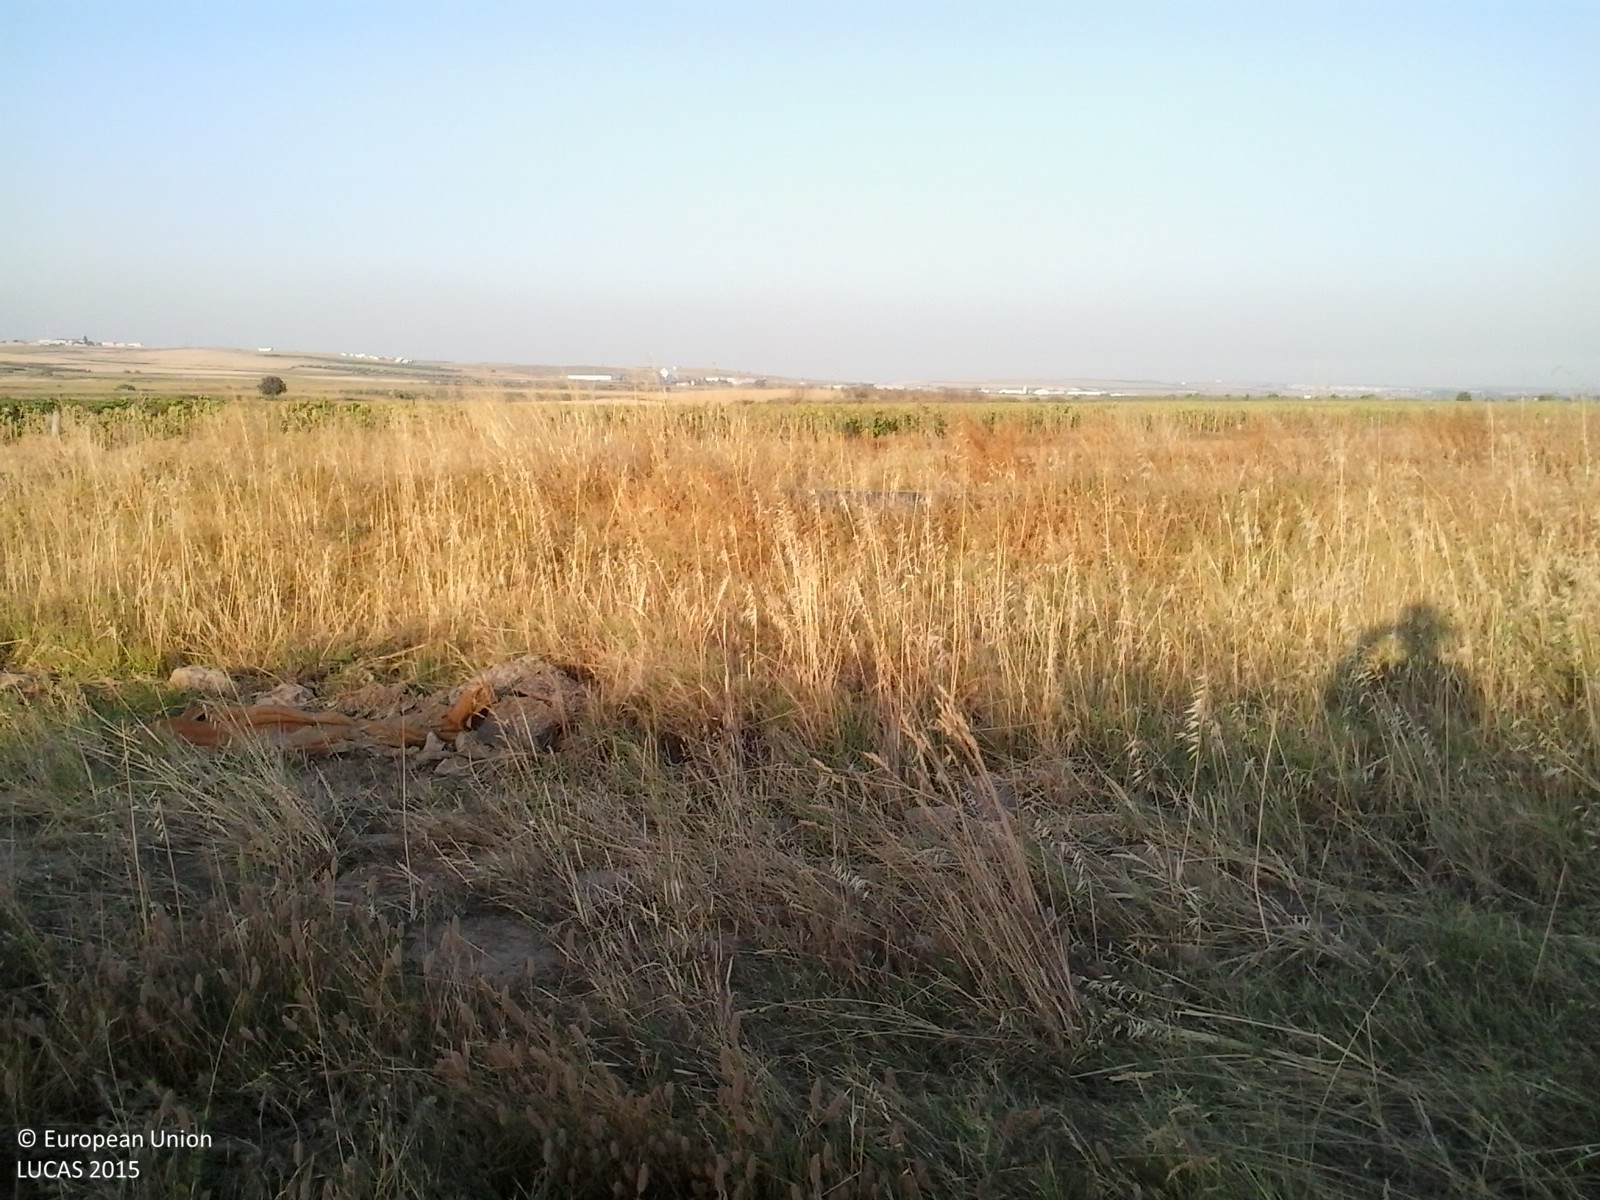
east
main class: Grassland
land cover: Grassland without tree/shrub cover
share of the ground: > 75 %
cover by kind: herbaceous plants 90 %, shrubs 5 %, unconsolidated bare surface 5 %
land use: Abandoned areas
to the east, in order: Grassland without tree/shrub cover; Ditches and canals; Grass margins; Paved roads, cycling and walking lanes; Grass margins; Ditches and canals; Grass margins; Sunflower; Grass margins; Common wheat; Grass margins; Sunflower
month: June
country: ES
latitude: 37.3981
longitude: -6.4220
